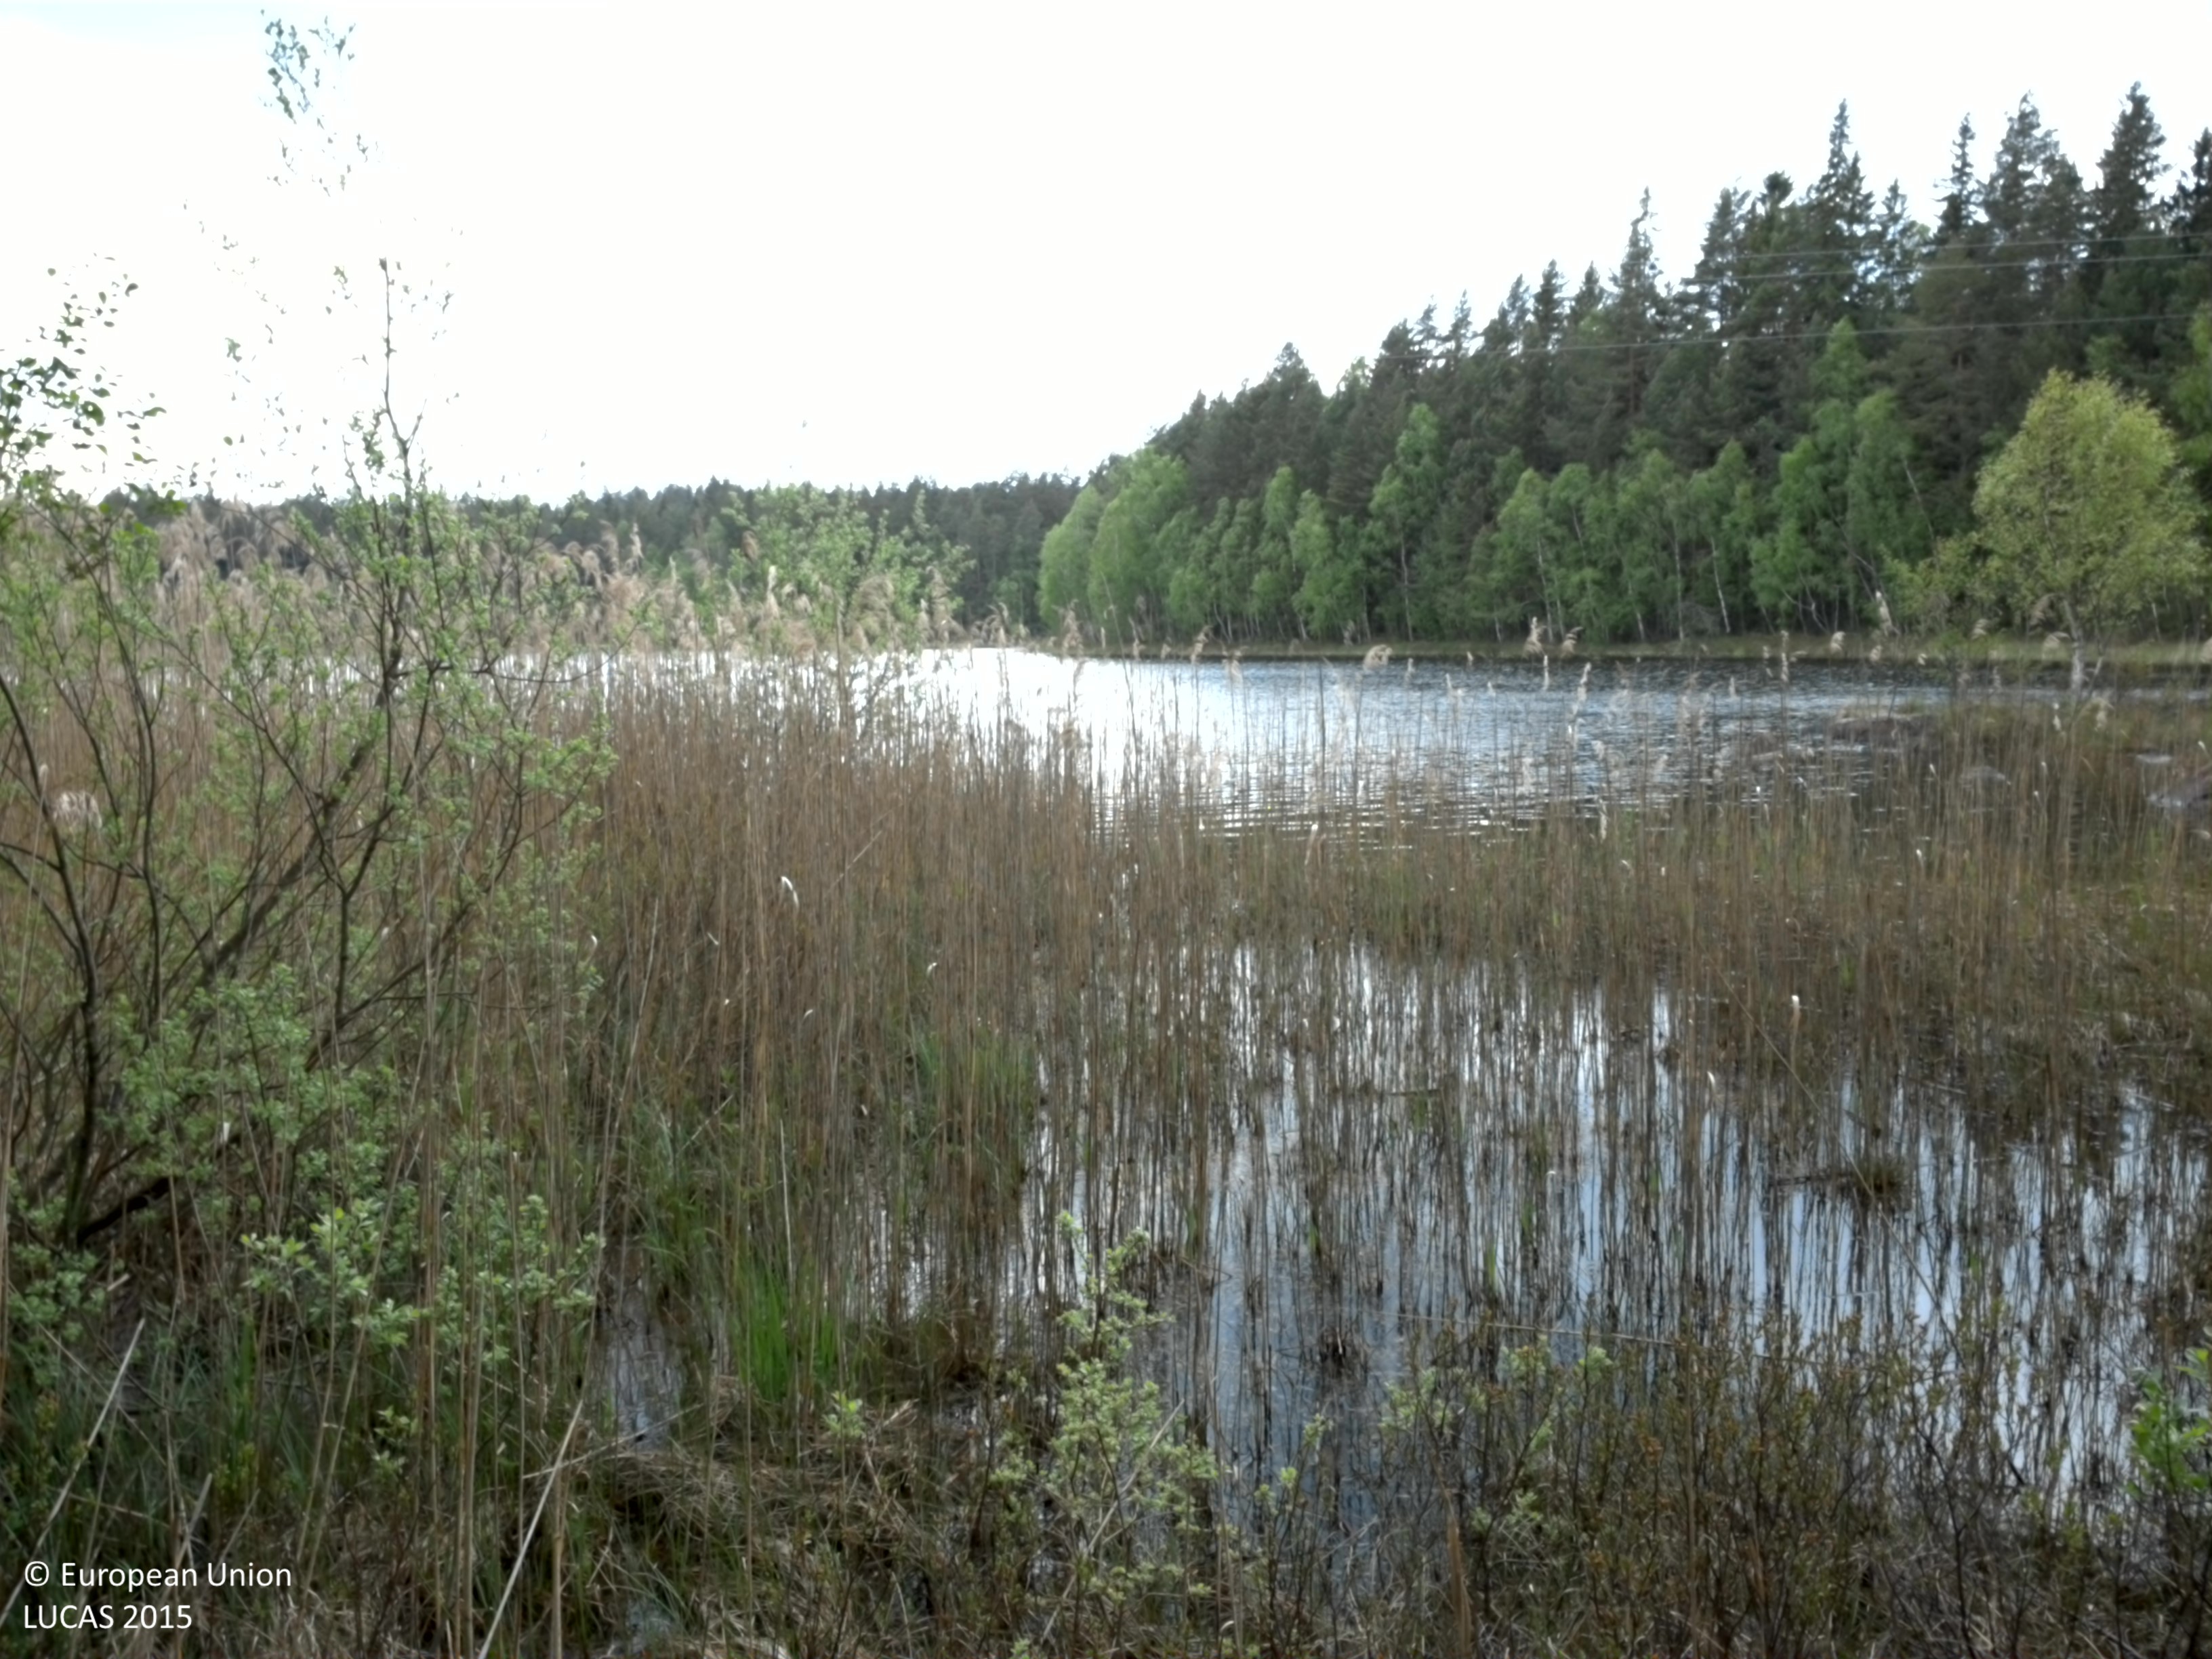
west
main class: Shrubland
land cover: Shrubland with sparse tree cover
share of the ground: 25 - 50 %
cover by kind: lichens and mosses 60 %, shrubs 25 %, herbaceous plants 10 %, broadleaved forest trees 5 %
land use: Semi-natural and natural areas not in use
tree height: < 5 m
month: May
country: SE
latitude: 57.4215
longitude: 15.5086
